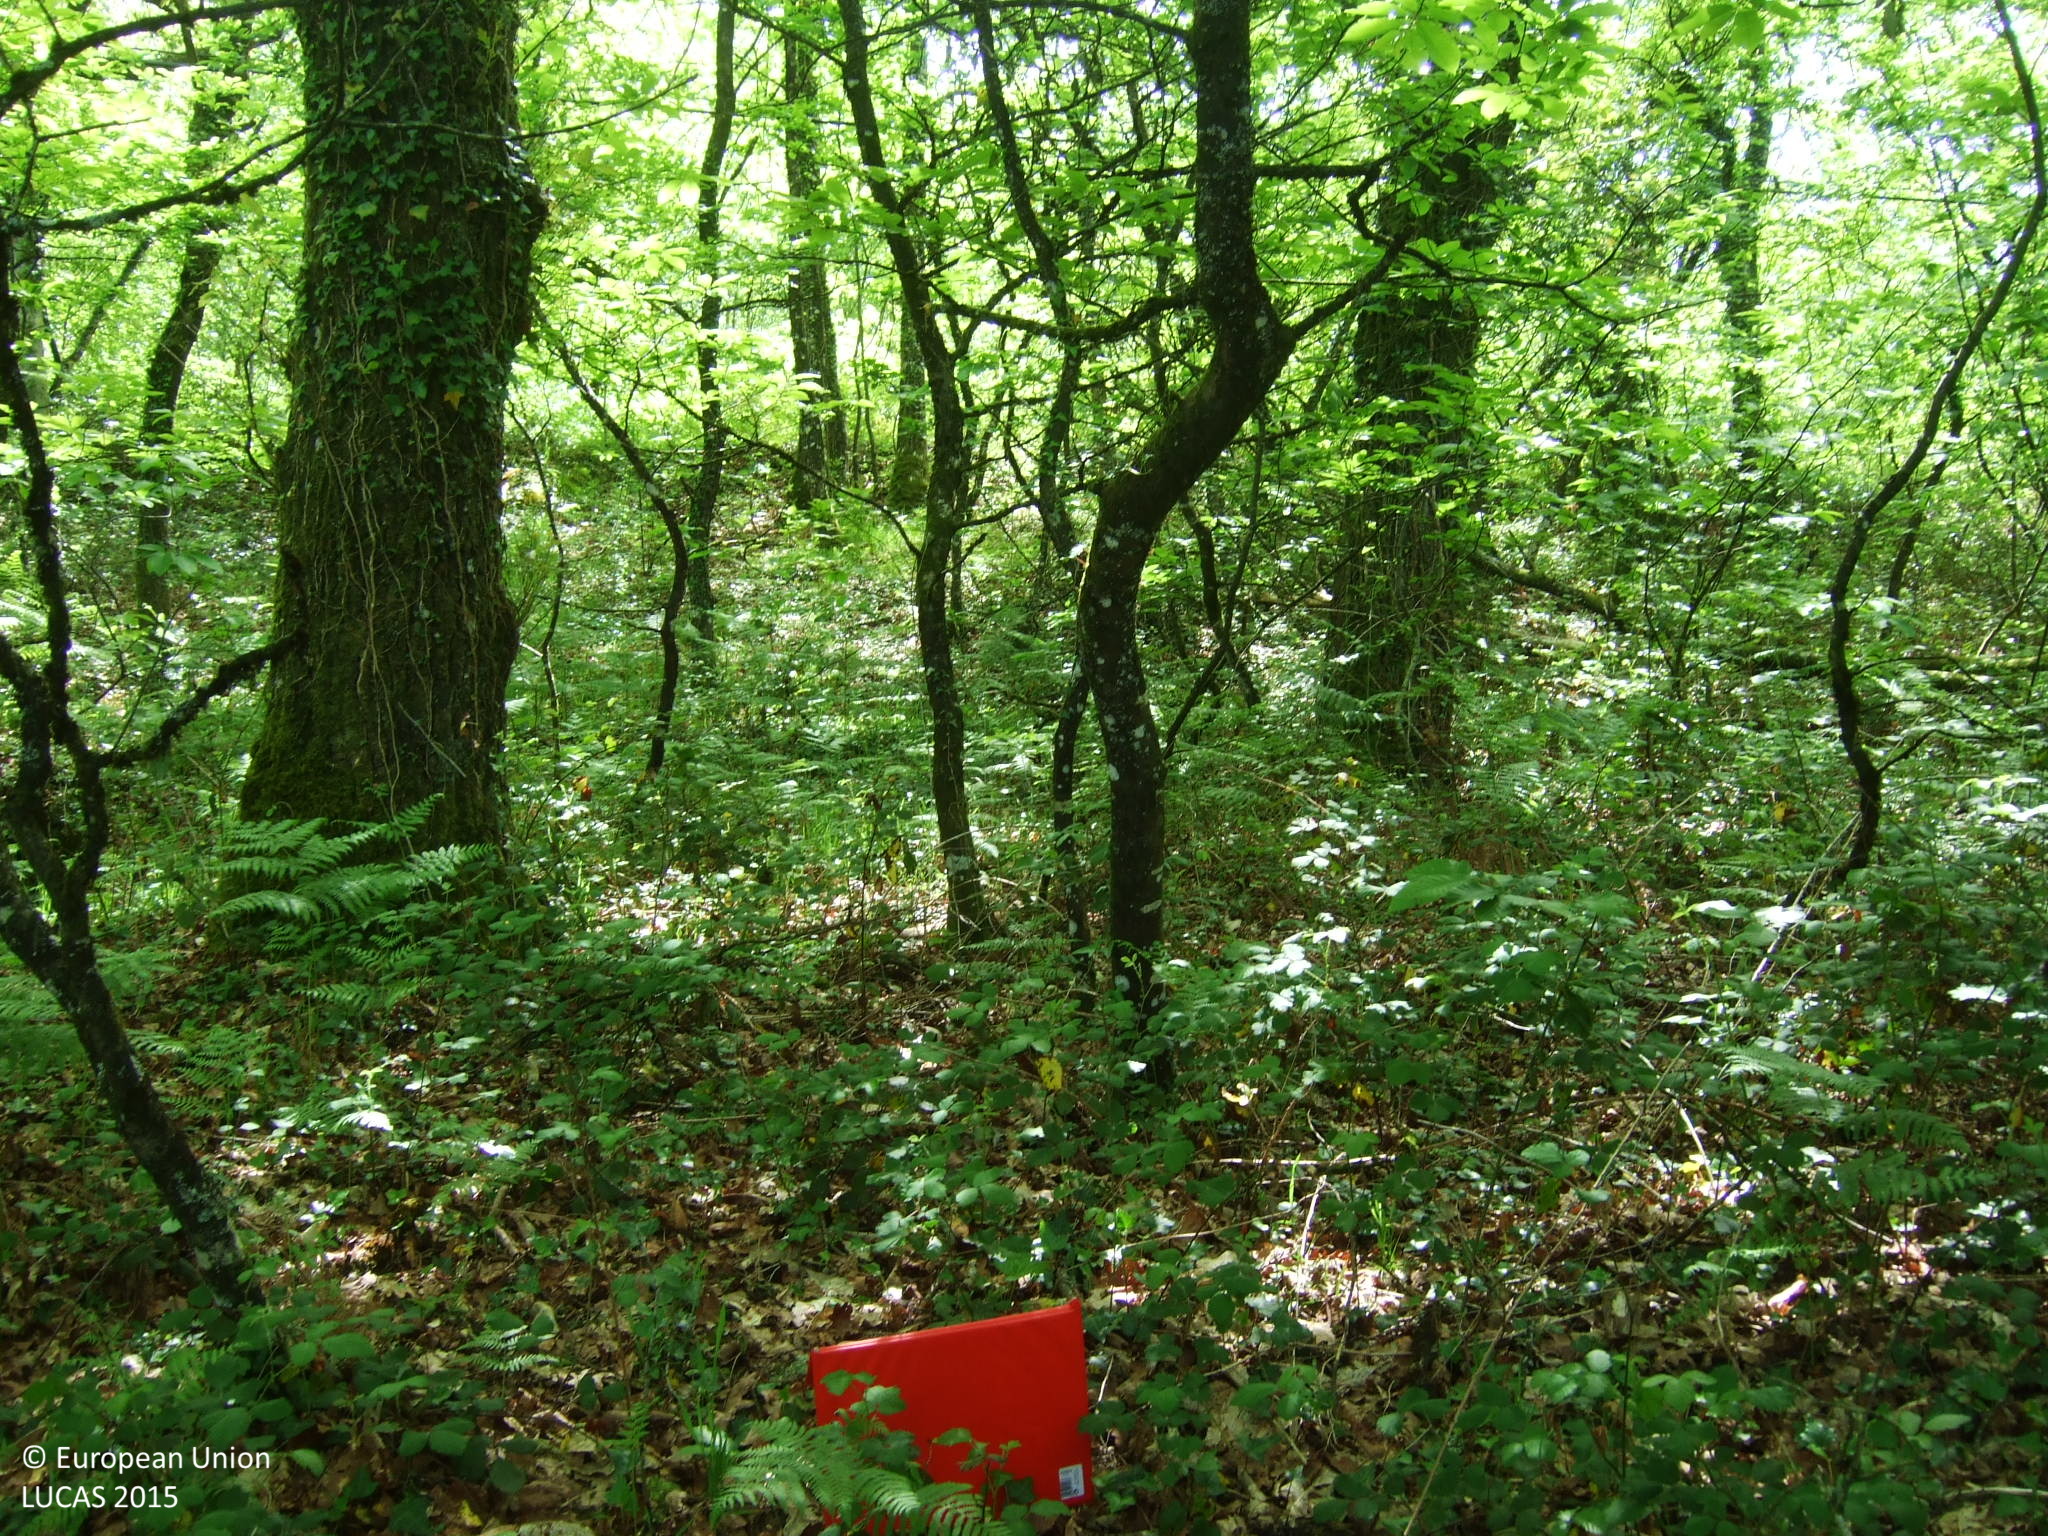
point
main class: Woodland
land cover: Broadleaved woodland
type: acidophilous oak and oak-birch forest
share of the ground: > 75 %
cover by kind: broadleaved forest trees 80 %, shrubs 10 %, unconsolidated bare surface 10 %
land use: Forestry
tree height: > 5 m
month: May
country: ES
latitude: 43.0248
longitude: -7.3376
